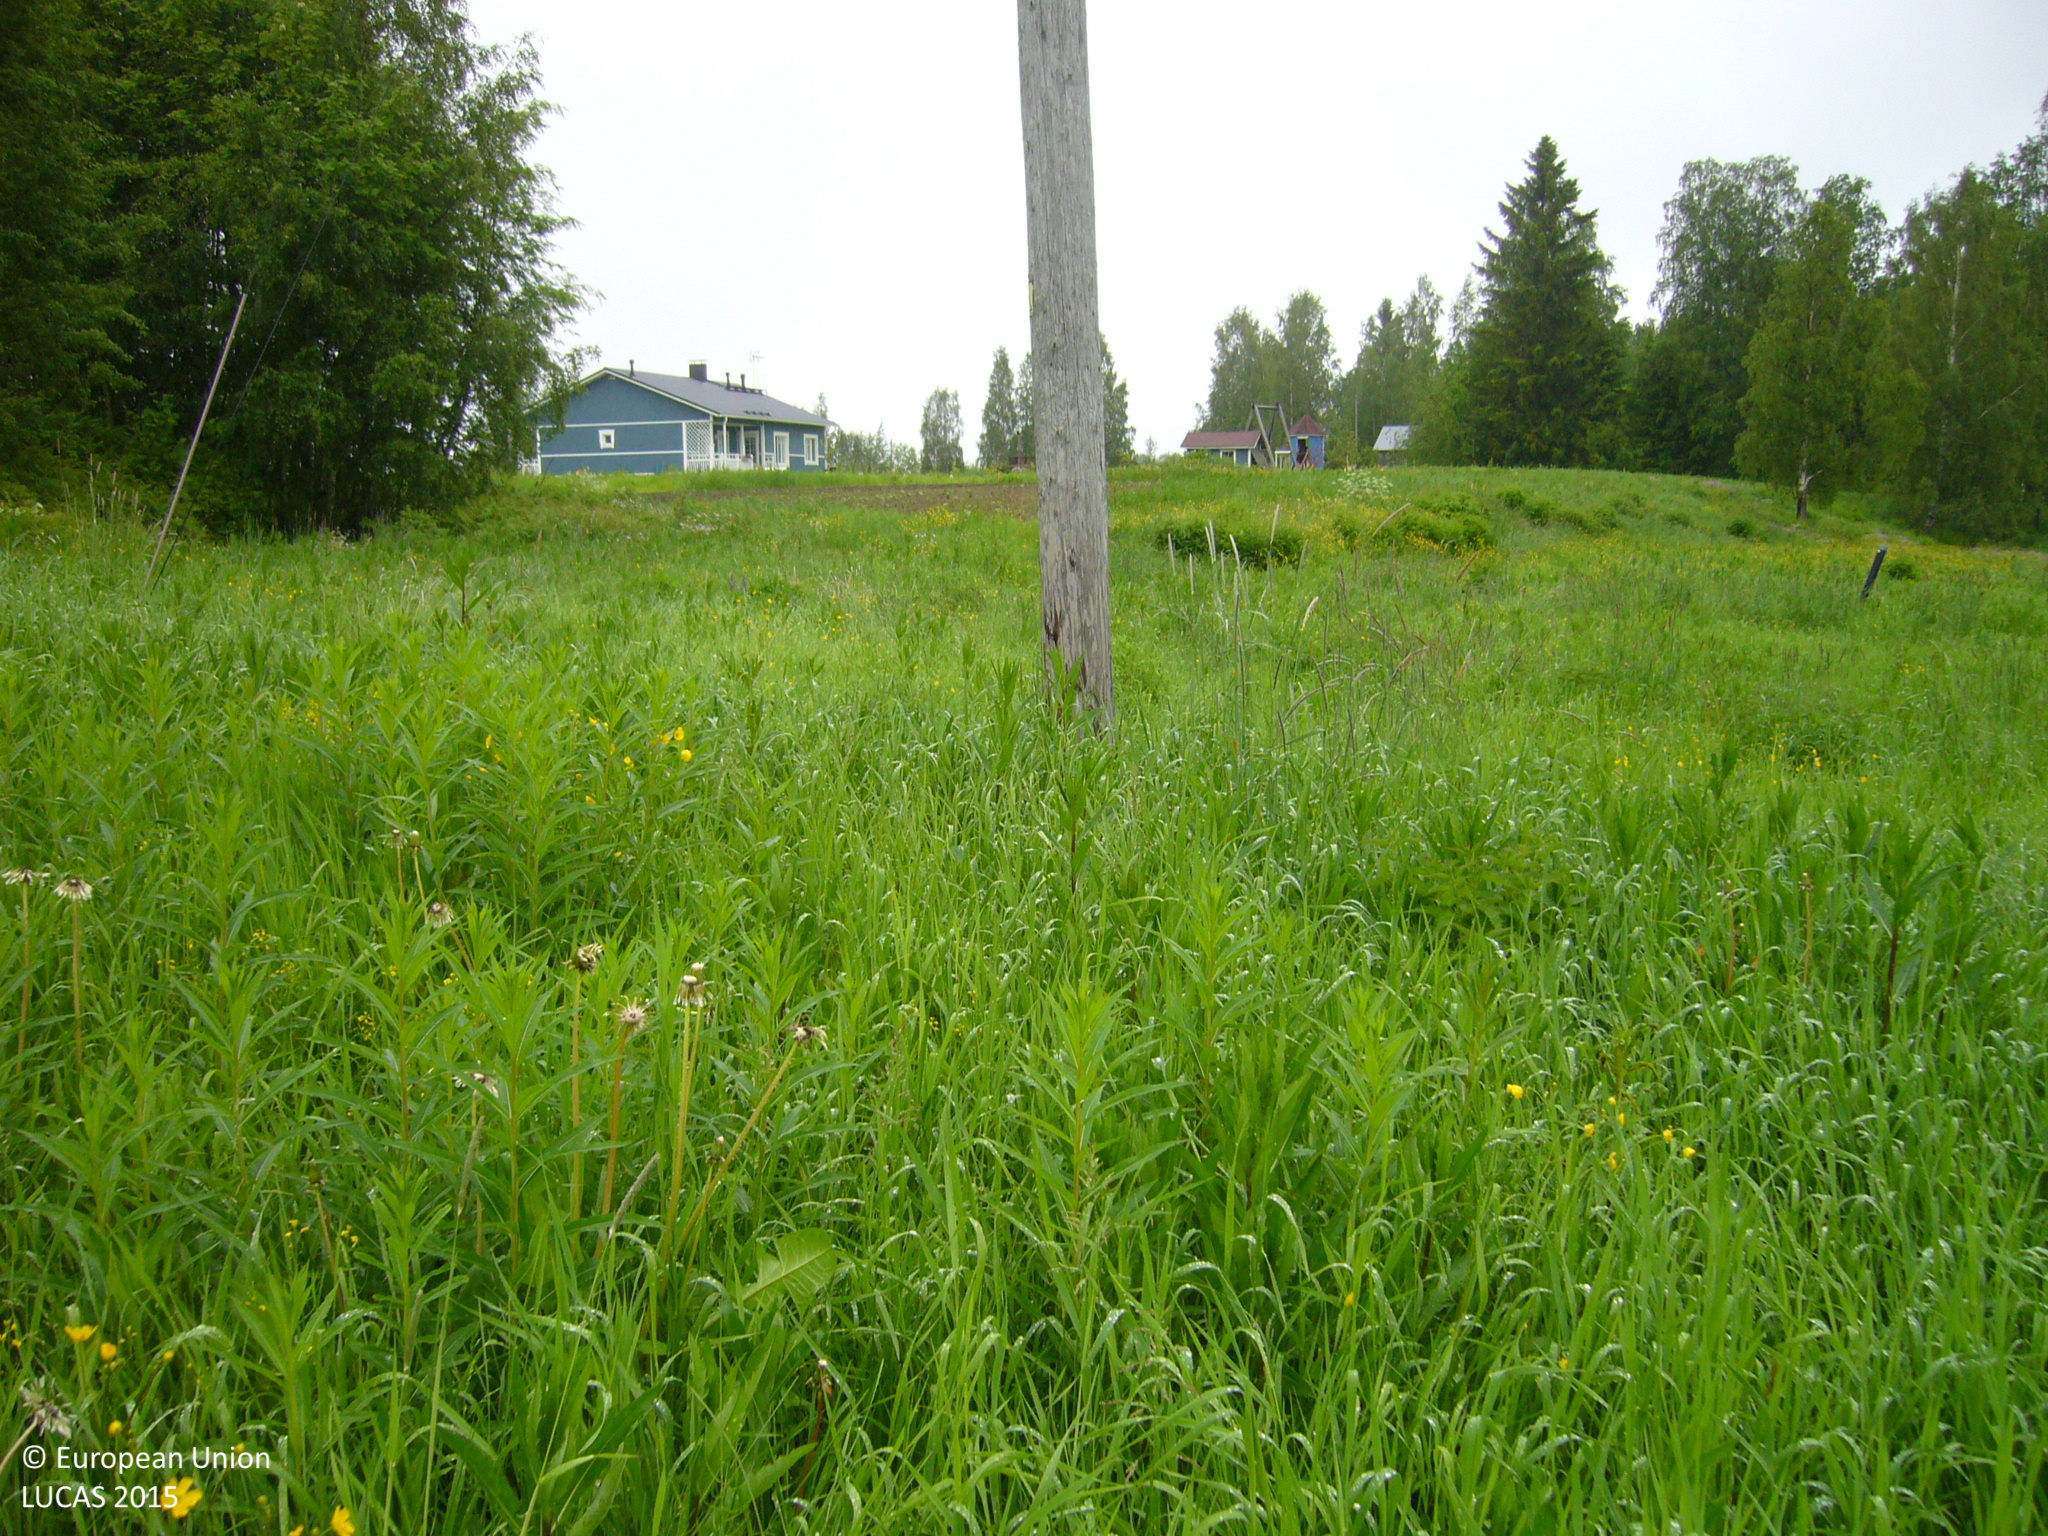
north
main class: Grassland
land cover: Grassland without tree/shrub cover
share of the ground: > 75 %
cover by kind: herbaceous plants 100 %
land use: Agriculture (excluding fallow land and kitchen gardens)
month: June
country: FI
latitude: 63.8309
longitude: 25.1493
